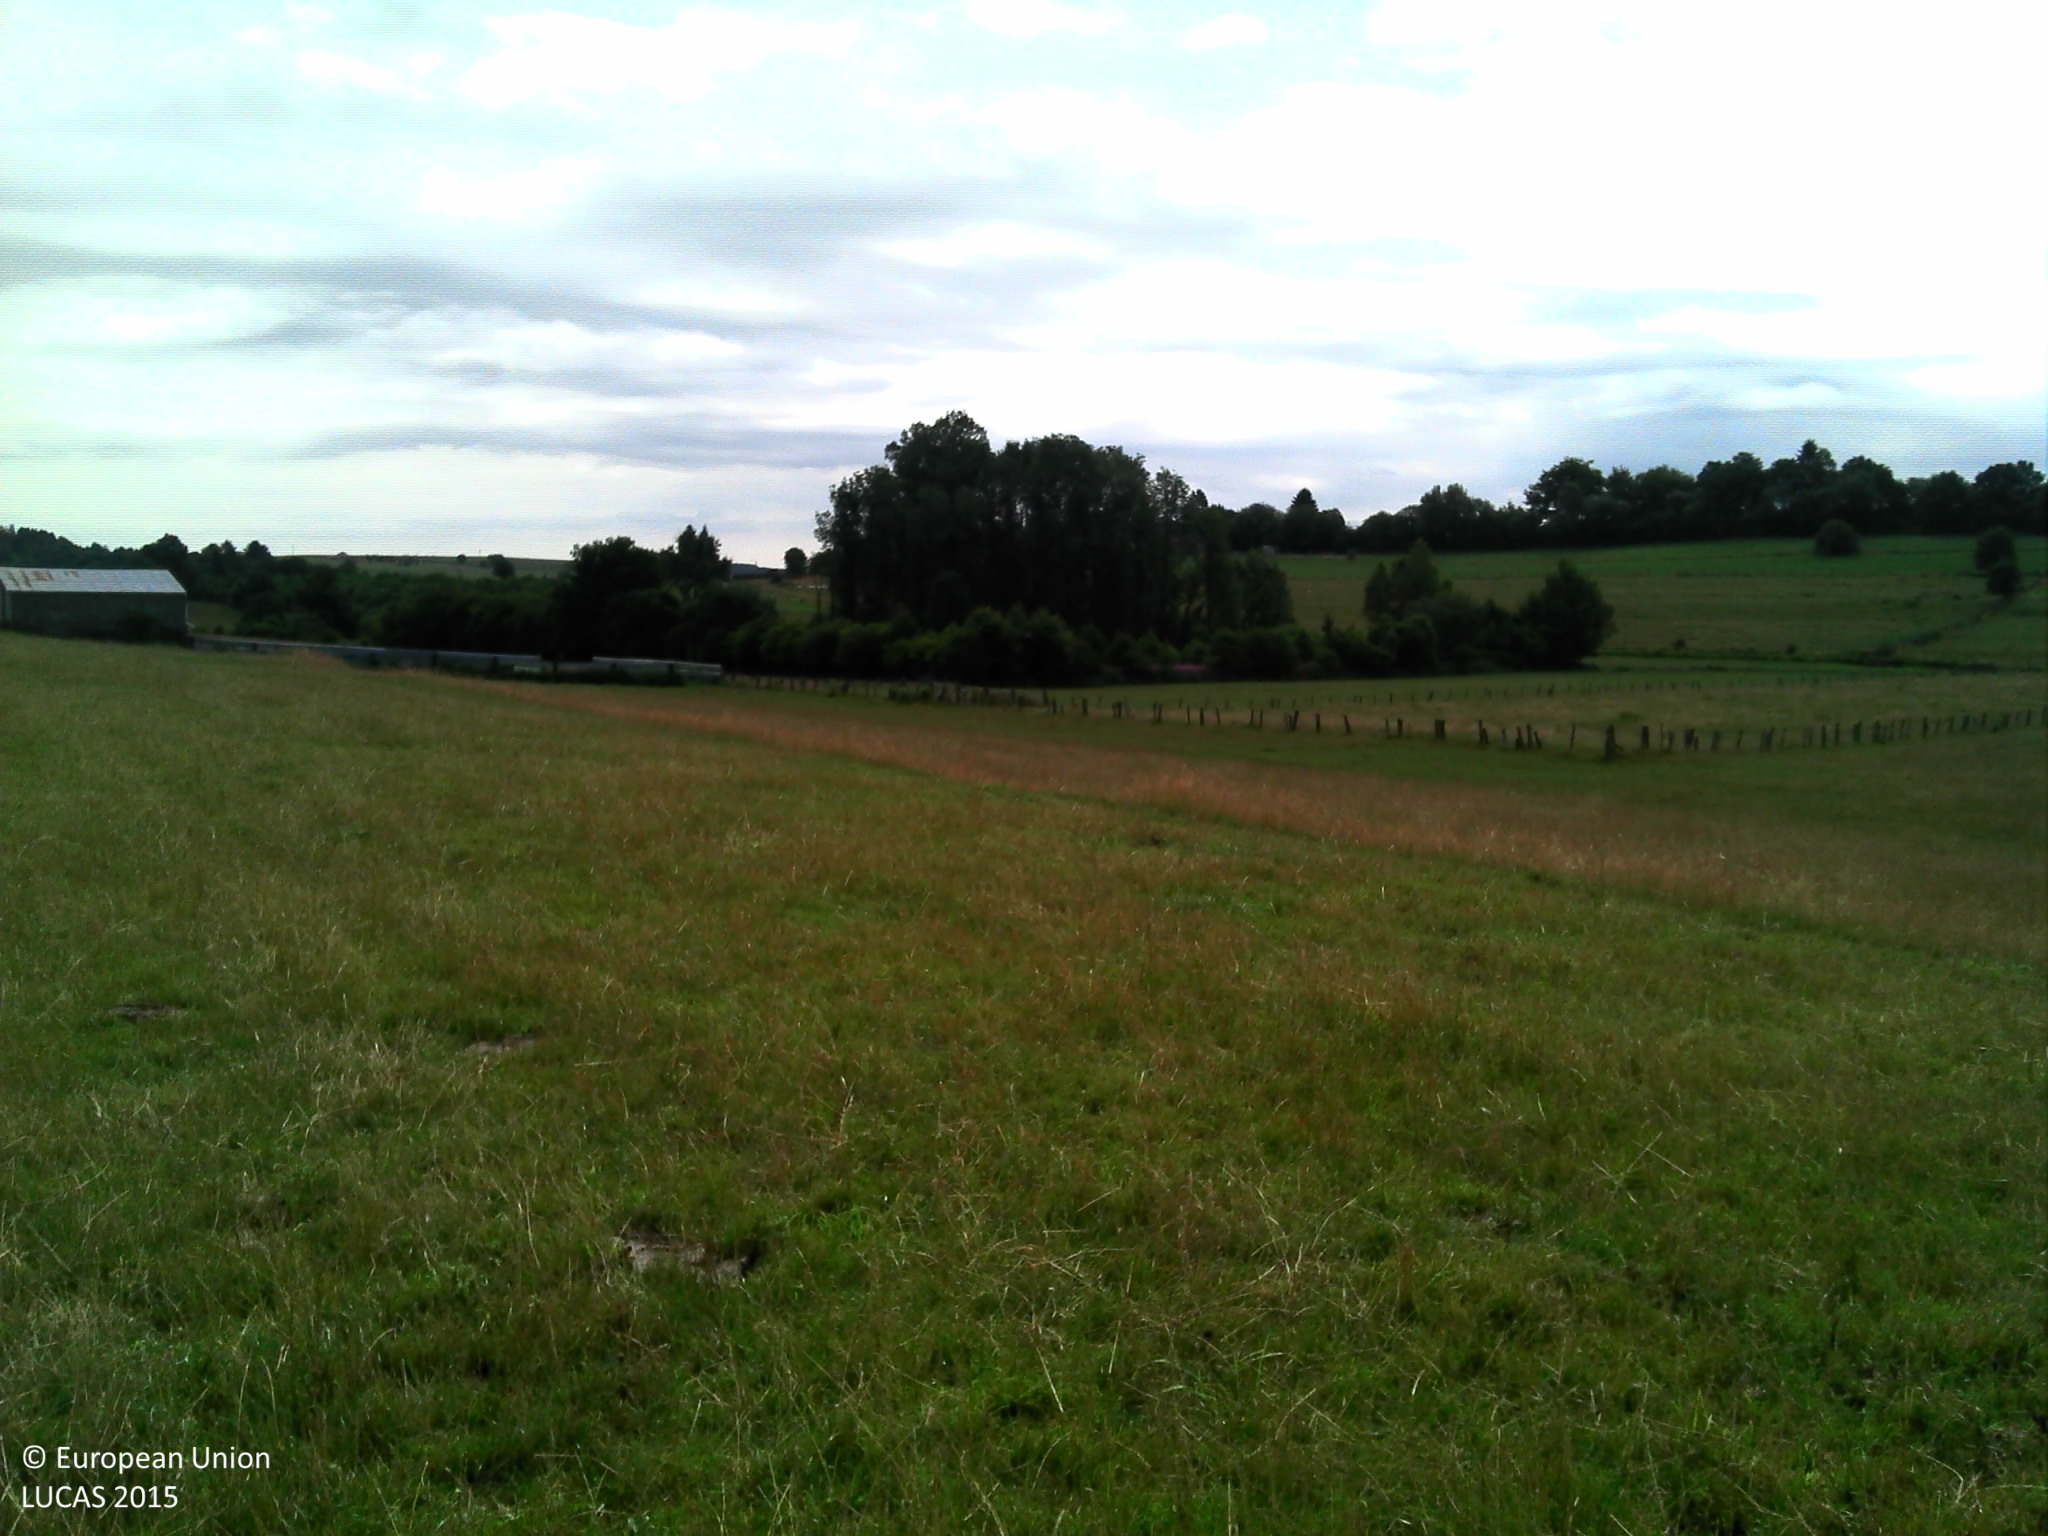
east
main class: Grassland
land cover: Grassland without tree/shrub cover
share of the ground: > 75 %
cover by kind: herbaceous plants 100 %
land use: Agriculture (excluding fallow land and kitchen gardens)
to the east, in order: Grassland without tree/shrub cover; Fences; Grassland without tree/shrub cover; Fences; Grassland without tree/shrub cover; Fences; Abandoned hedges; Spontaneously vegetated surfaces; Broadleaved woodland
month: July
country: BE
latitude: 49.8346
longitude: 5.2848
